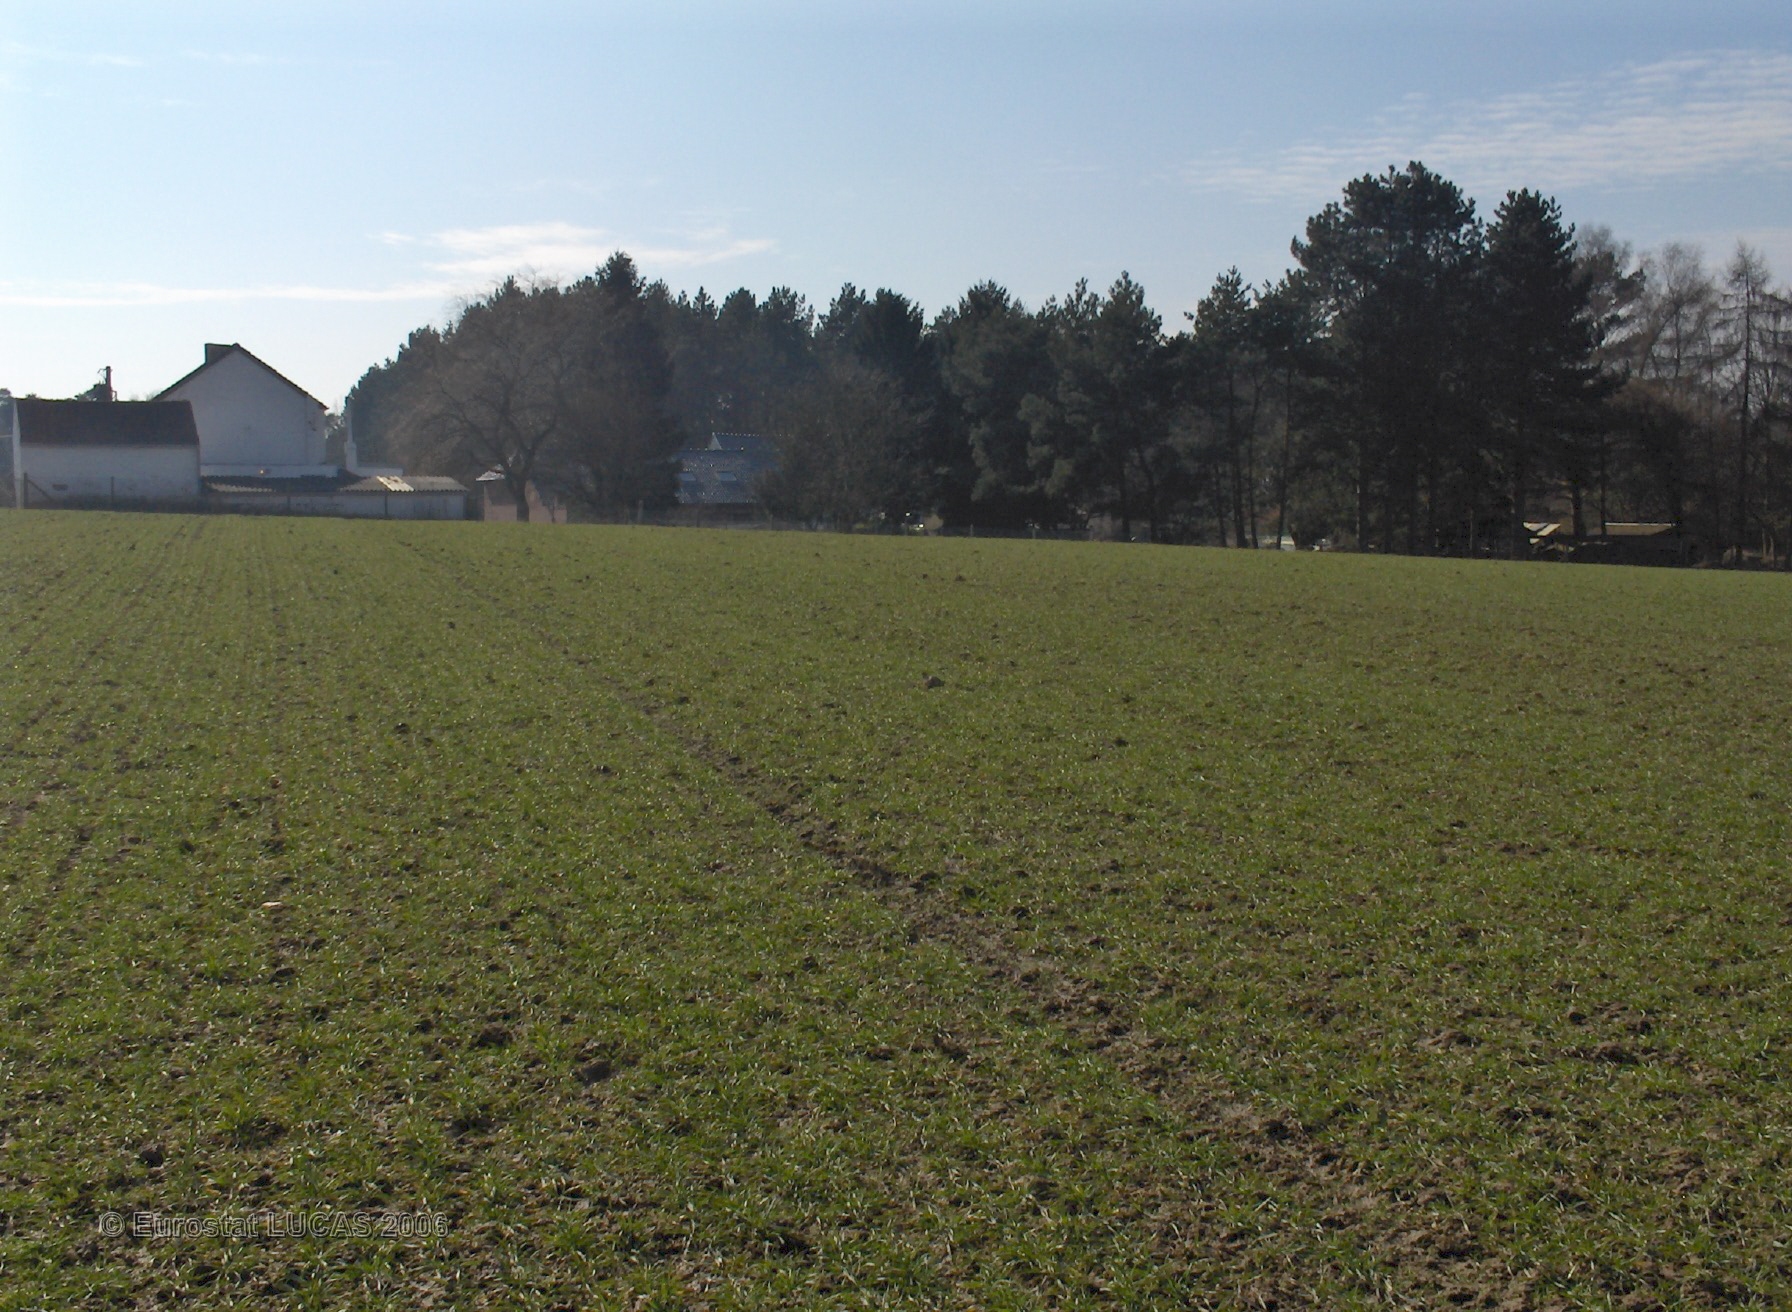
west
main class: Cropland
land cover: Common wheat
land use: Agriculture (excluding fallow land and kitchen gardens)
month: March
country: BE
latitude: 50.6129
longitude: 4.5551
